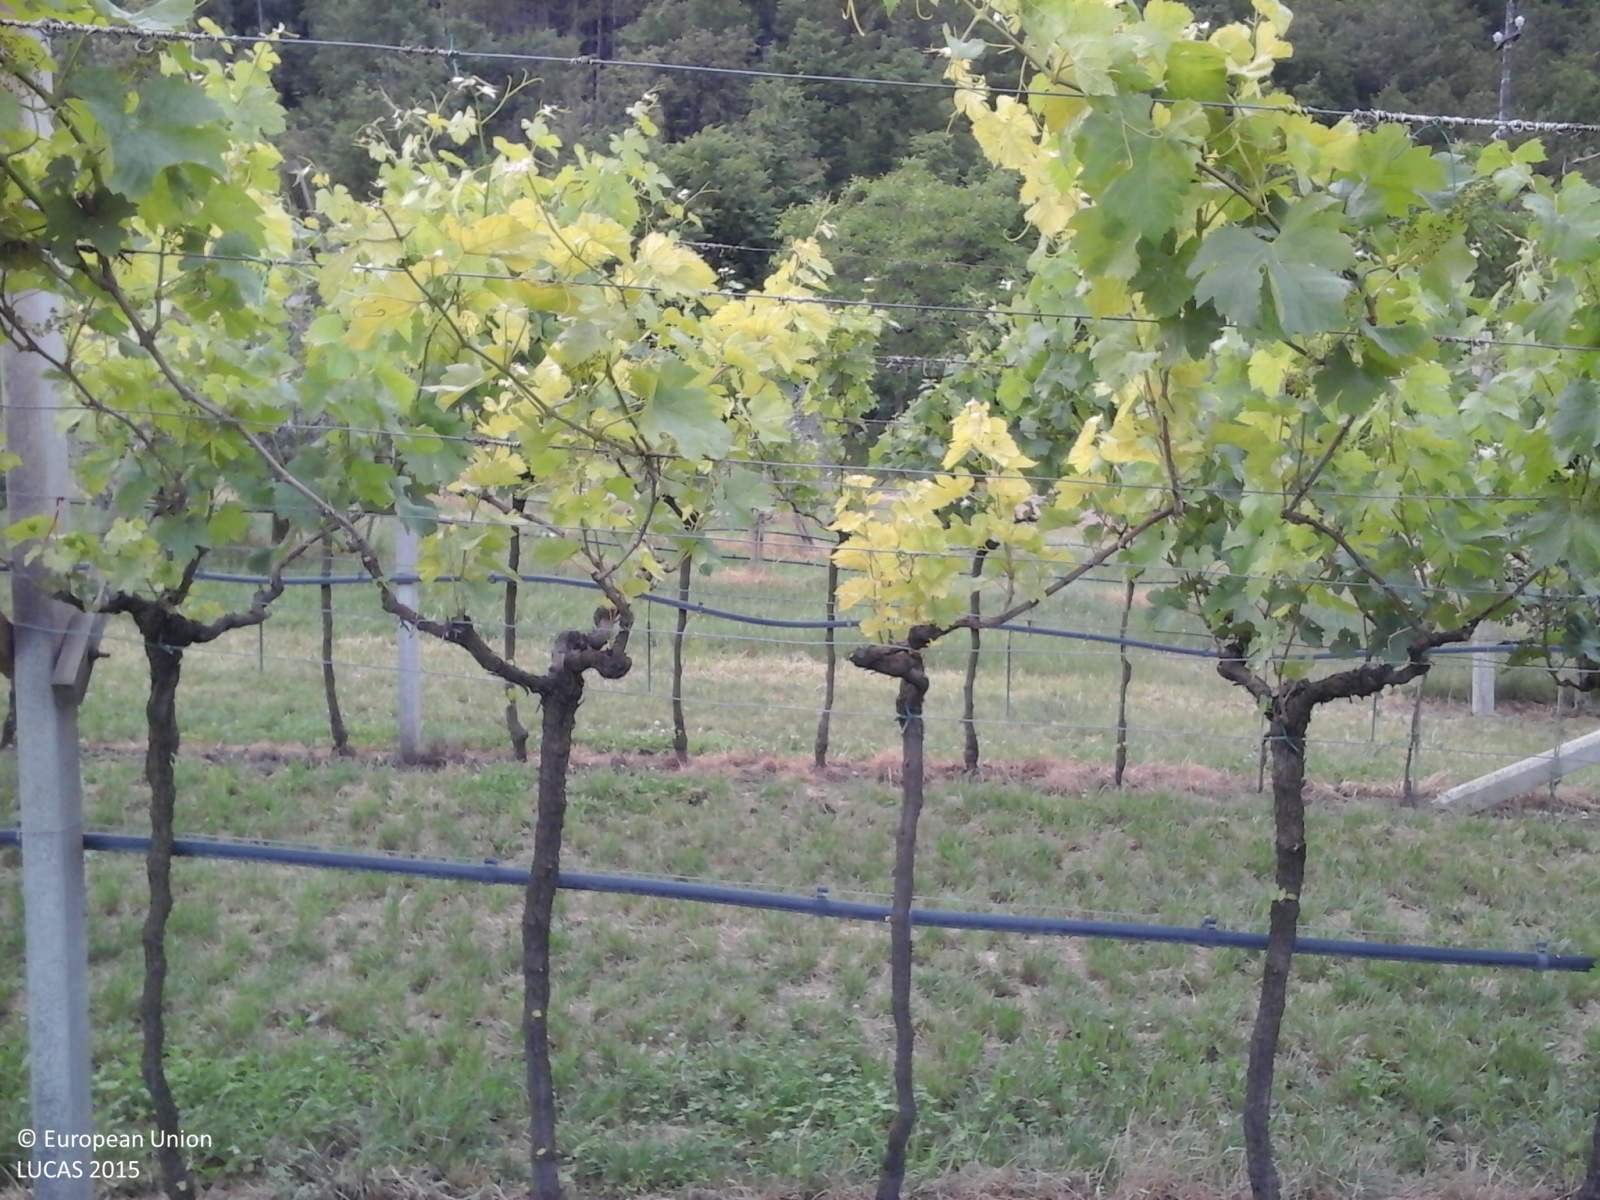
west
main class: Cropland
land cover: Vineyards
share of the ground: 10 - 25 %
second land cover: Grassland without tree/shrub cover
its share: > 75 %
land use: Agriculture (excluding fallow land and kitchen gardens)
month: June
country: IT
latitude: 46.0228
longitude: 10.9416
